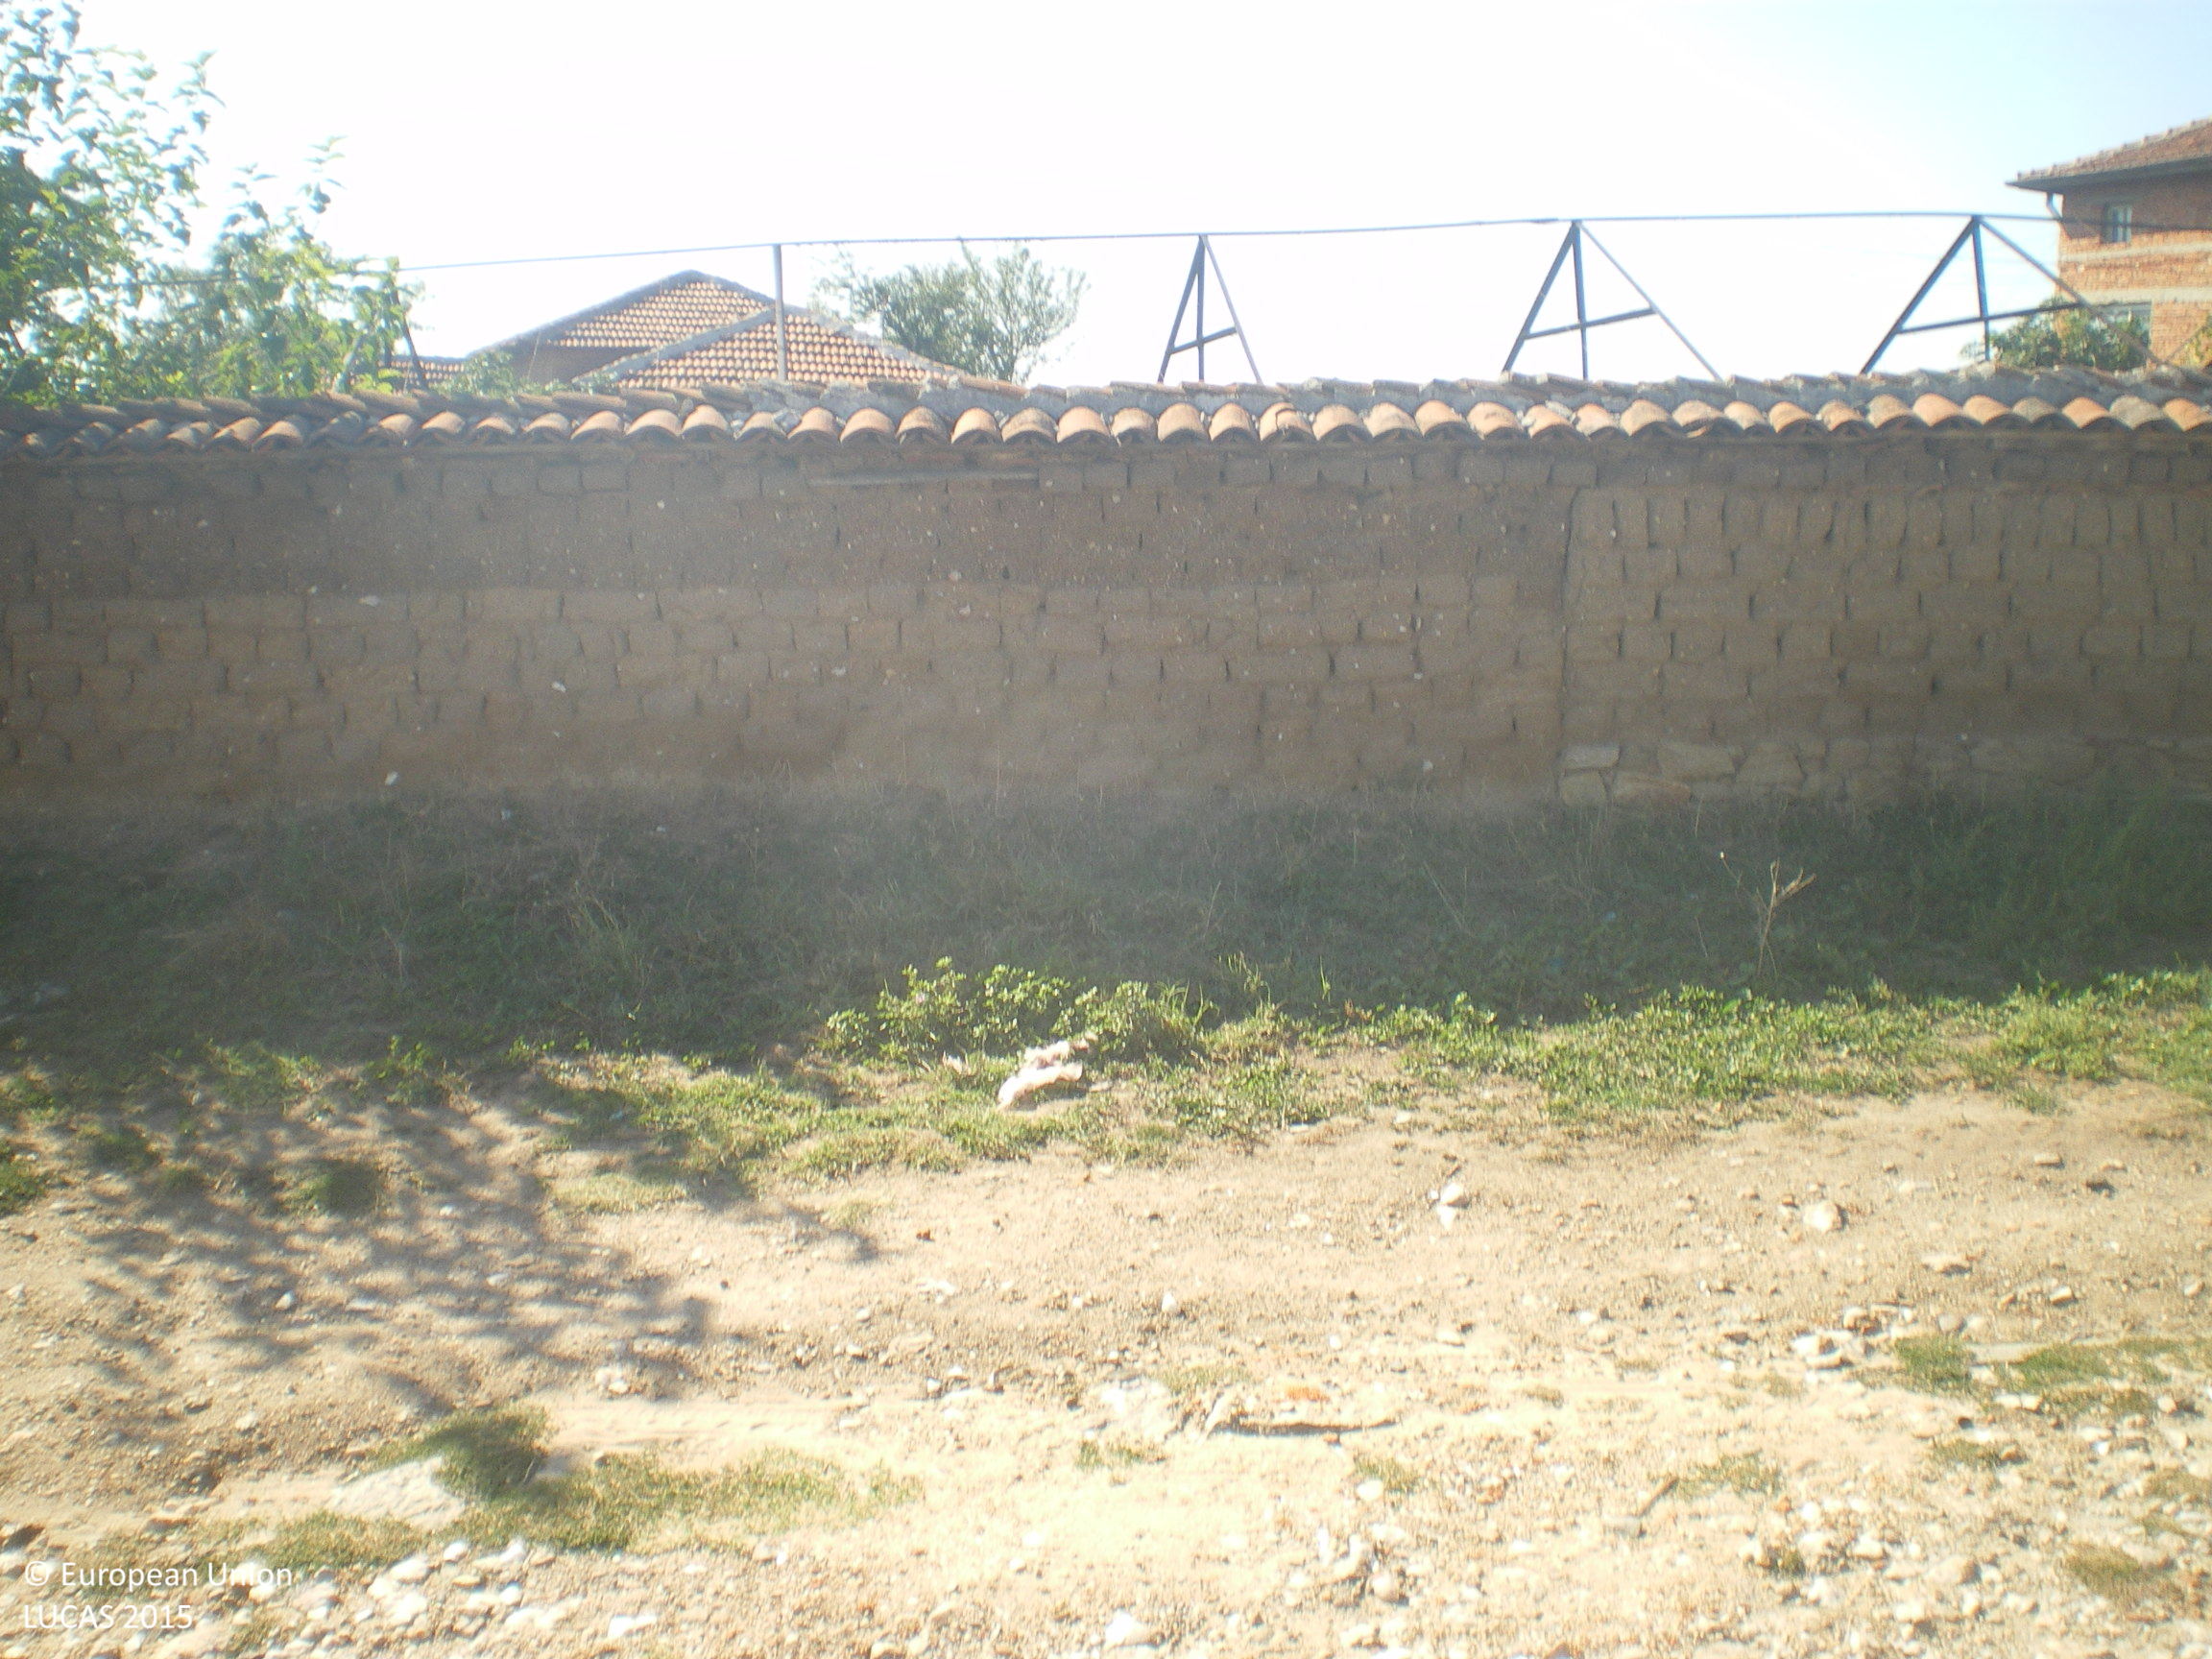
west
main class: Grassland
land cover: Grassland without tree/shrub cover
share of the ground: > 75 %
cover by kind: herbaceous plants 100 %
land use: Residential
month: September
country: BG
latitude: 41.8479
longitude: 25.7855
